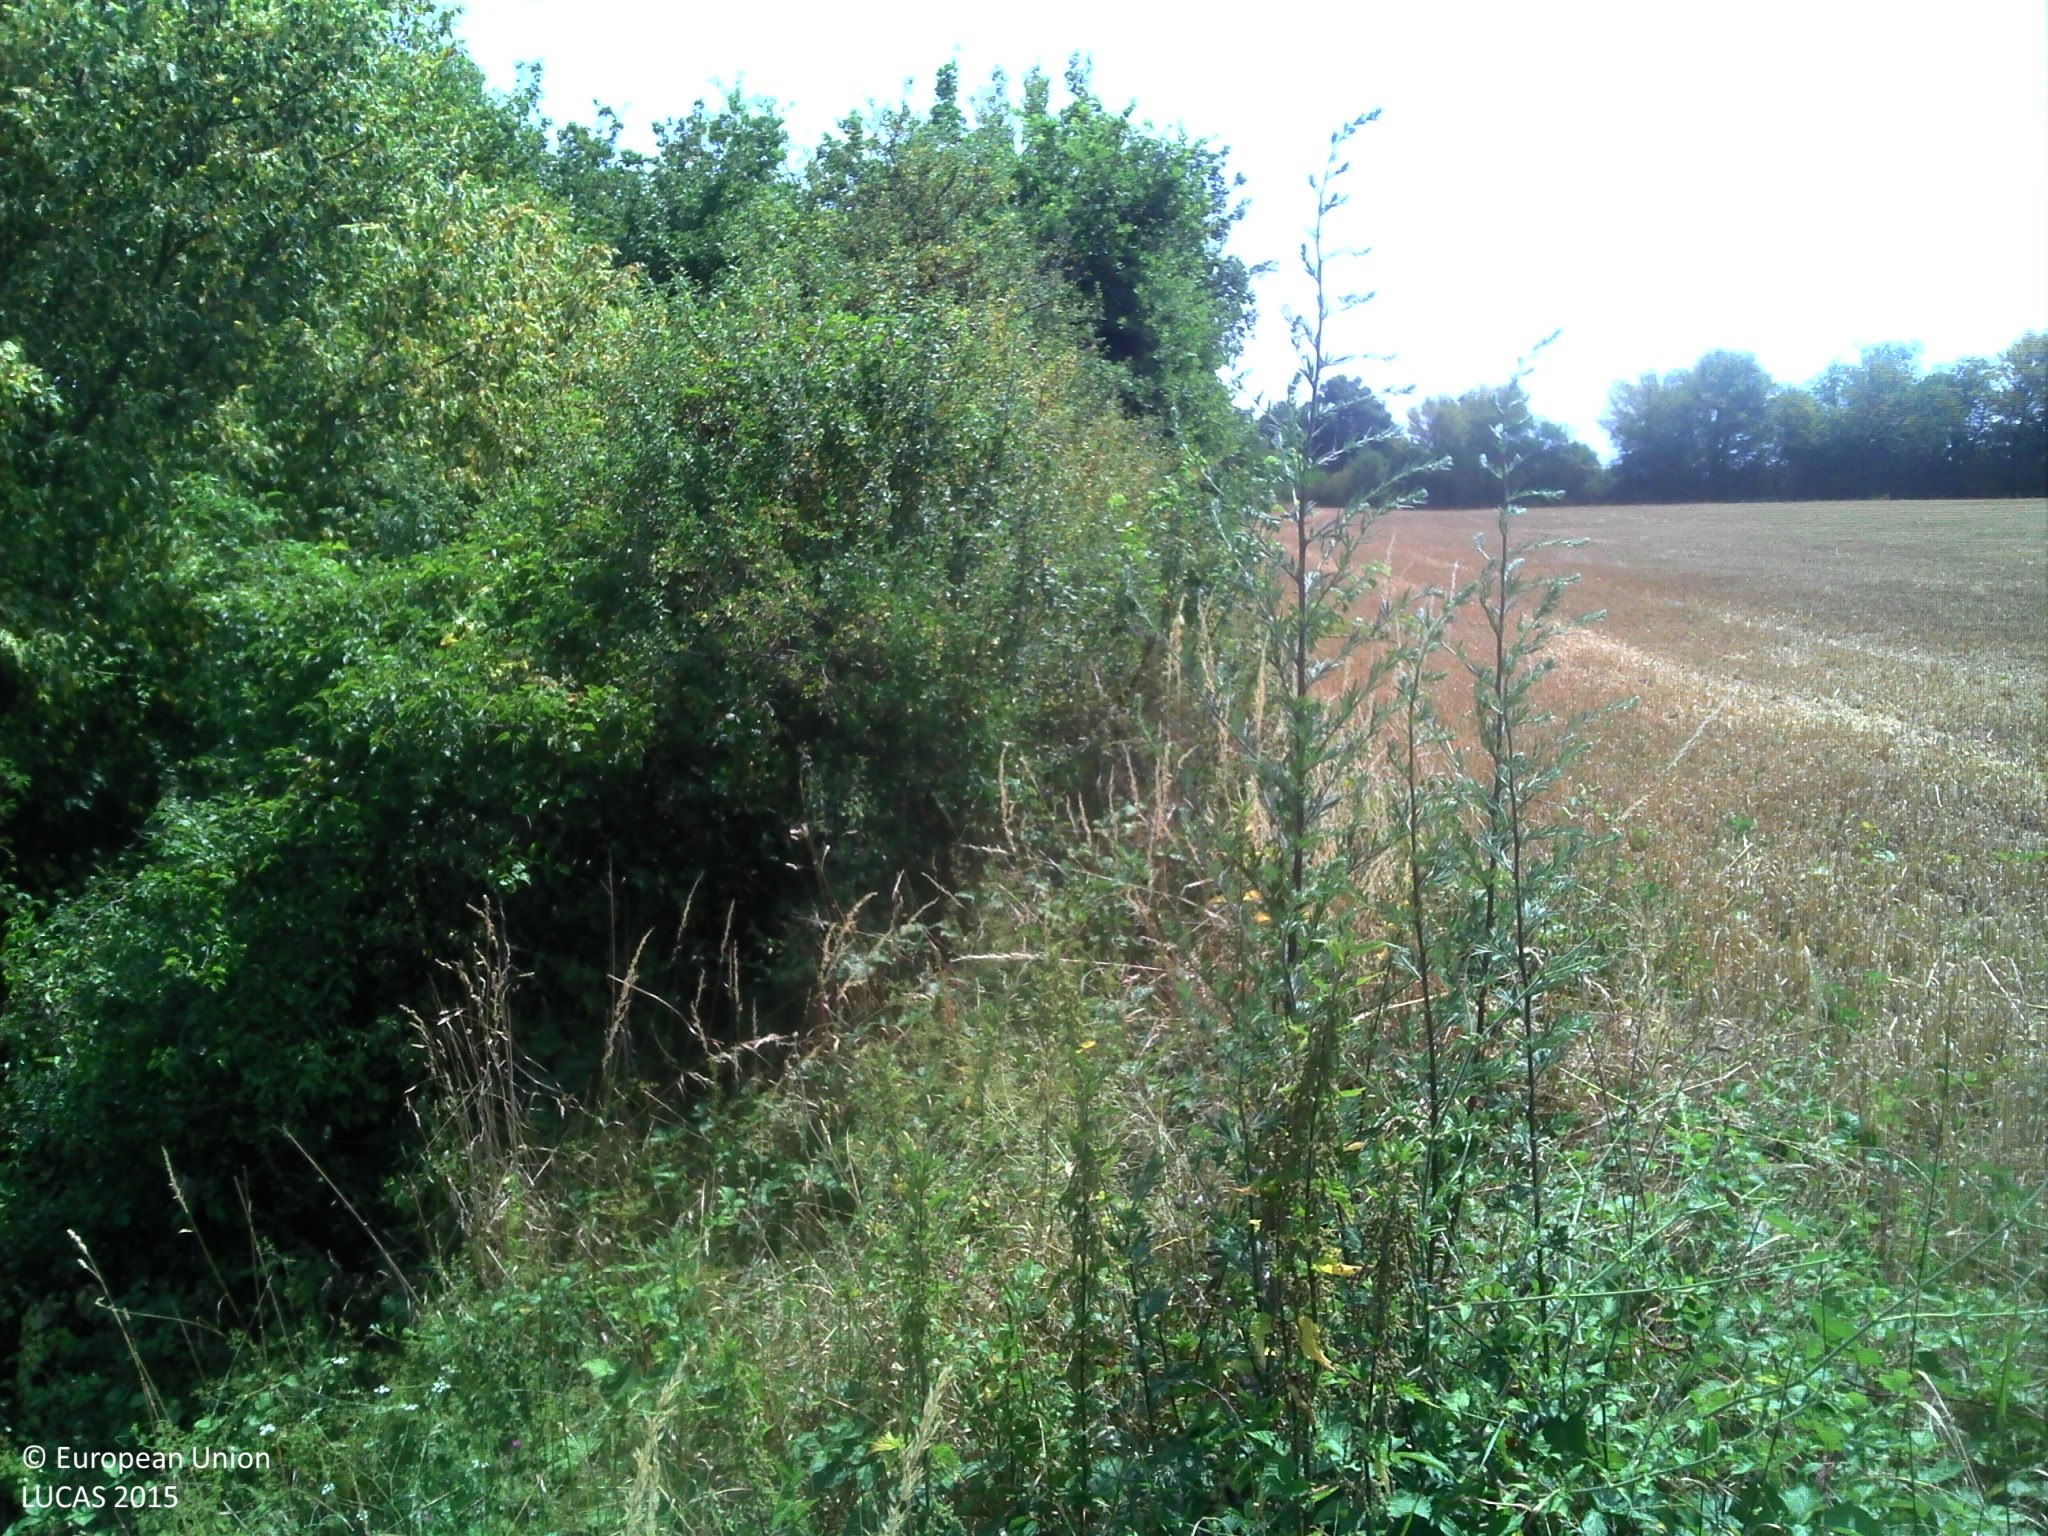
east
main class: Cropland
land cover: Maize
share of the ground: 50 - 75 %
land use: Agriculture (excluding fallow land and kitchen gardens)
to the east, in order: Maize
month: July
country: FR
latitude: 45.8071
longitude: 5.1269
